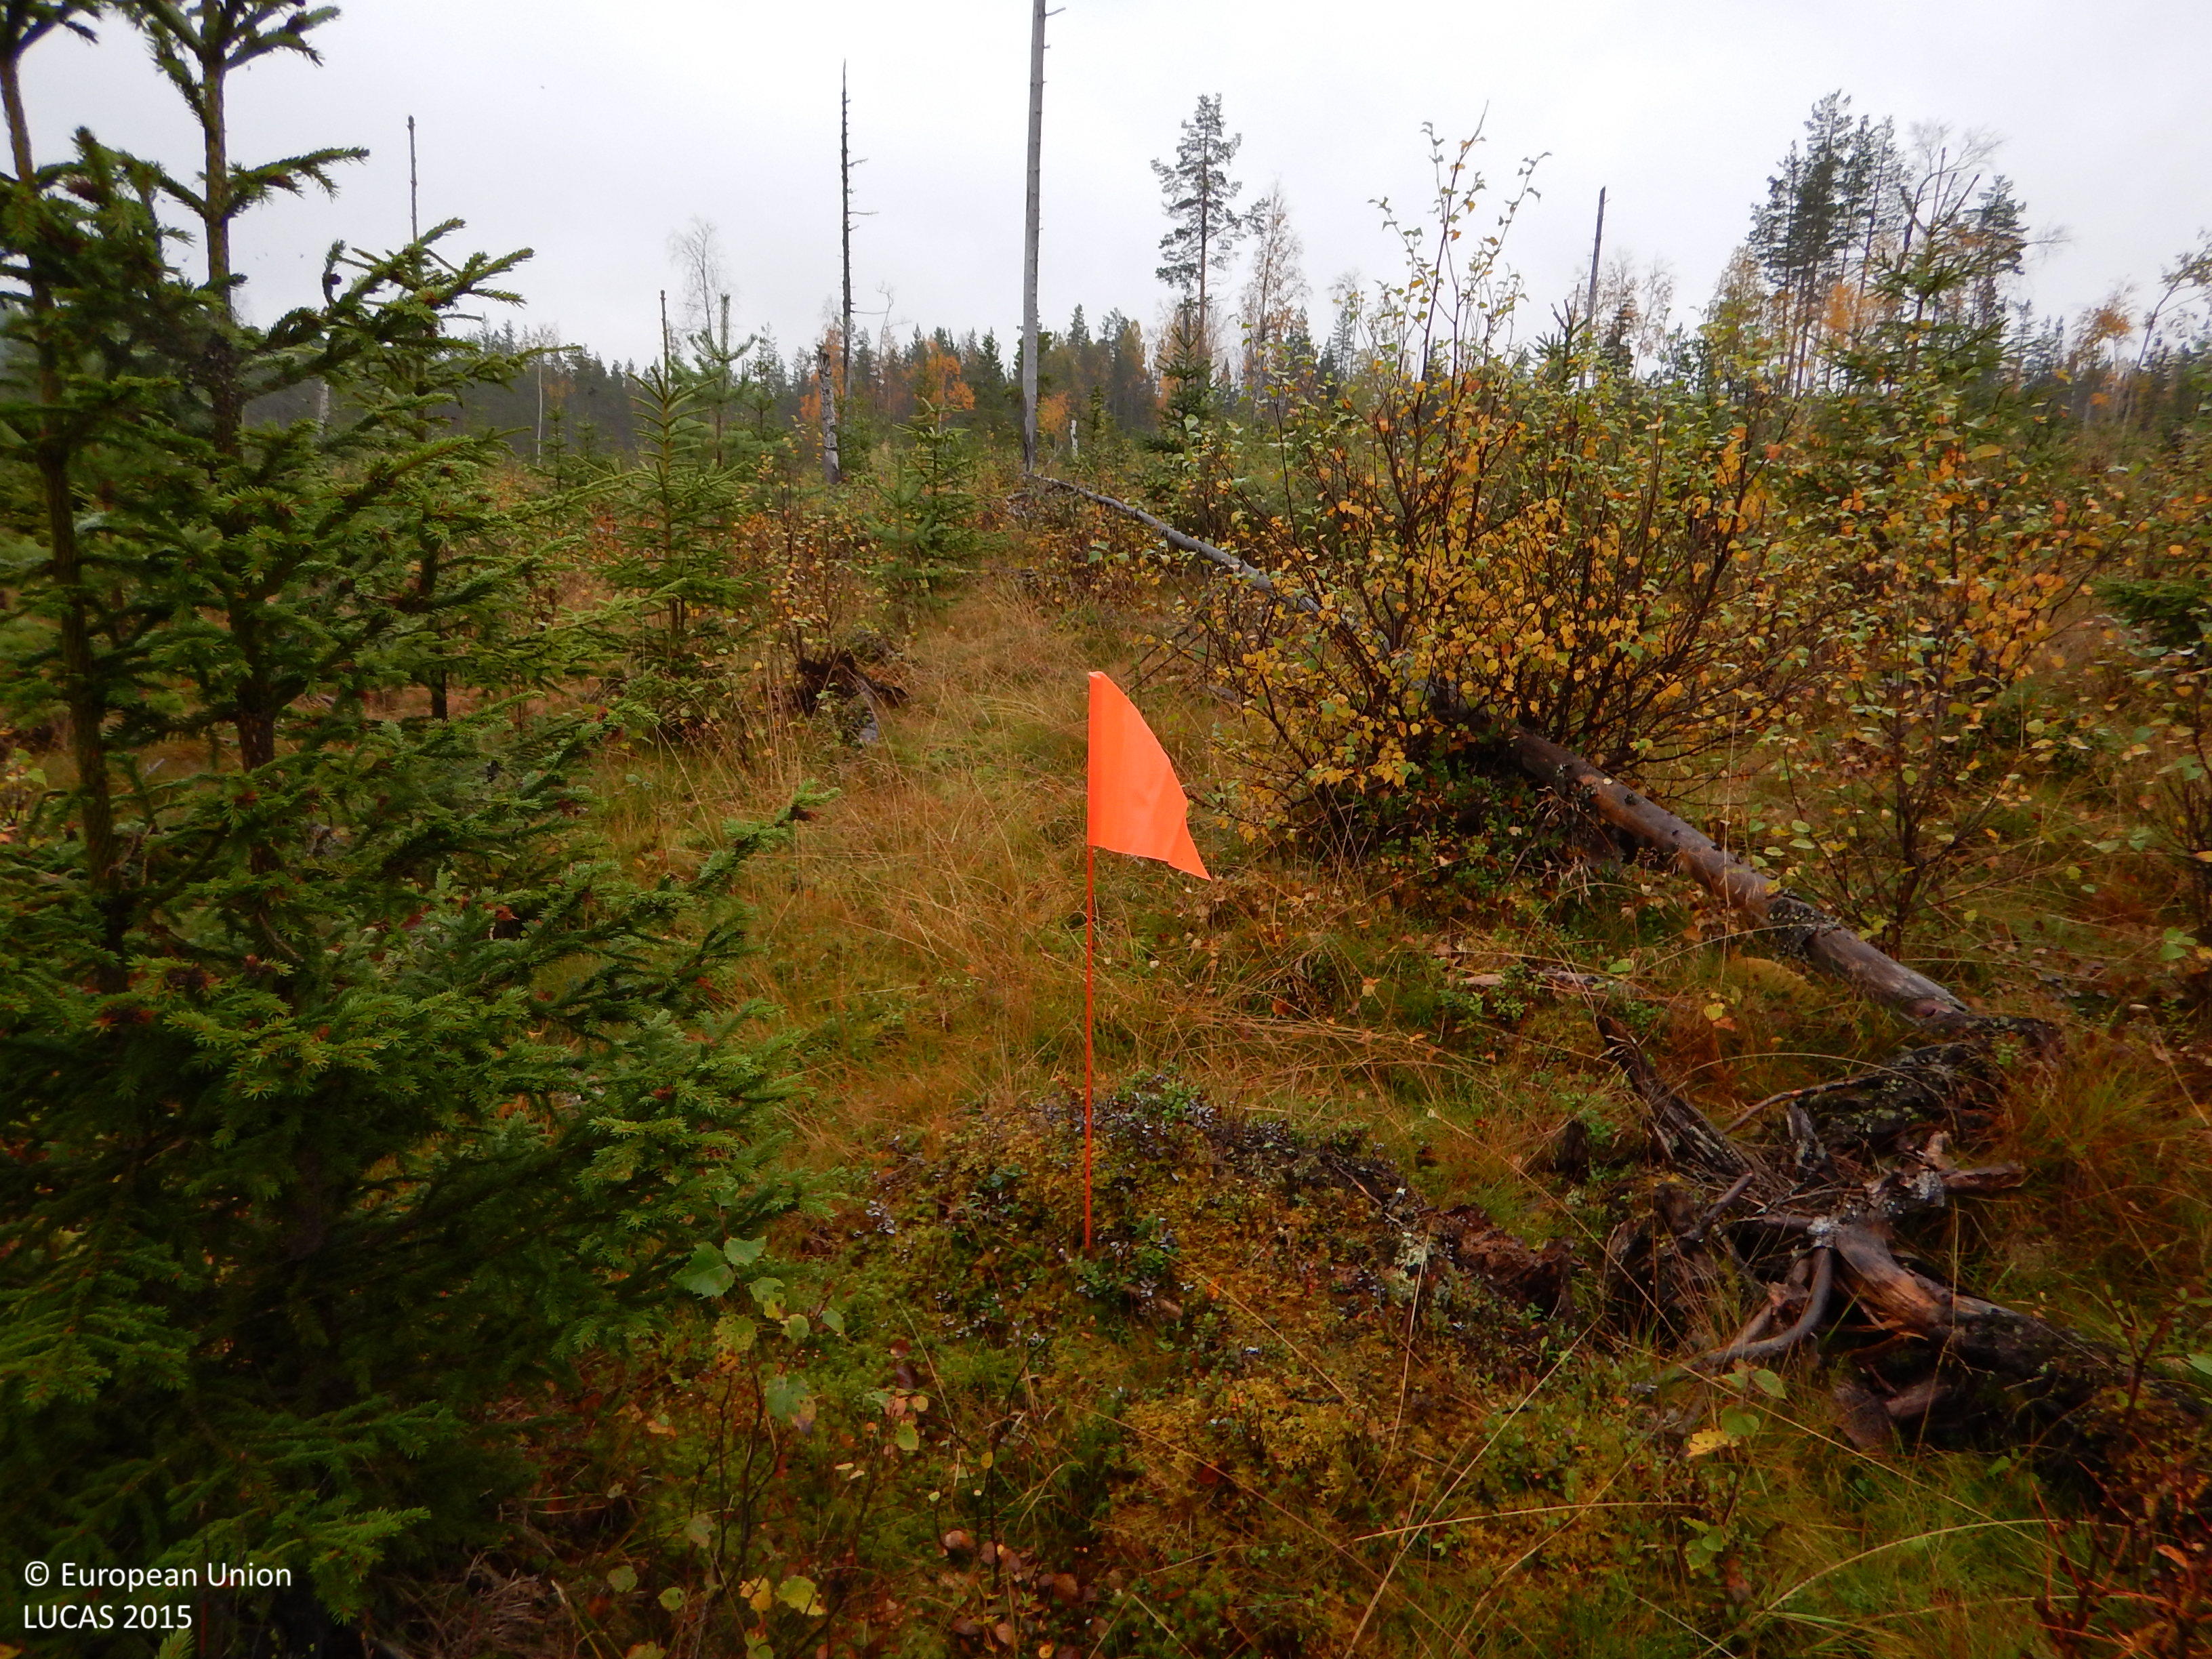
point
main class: Woodland
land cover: Other mixed woodland
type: boreal forest
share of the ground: 50 - 75 %
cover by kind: coniferous forest trees 35 %, broadleaved forest trees 20 %, lichens and mosses 20 %, herbaceous plants 15 %, shrubs 10 %
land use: Forestry
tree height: < 5 m
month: September
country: SE
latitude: 65.0385
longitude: 19.2465
